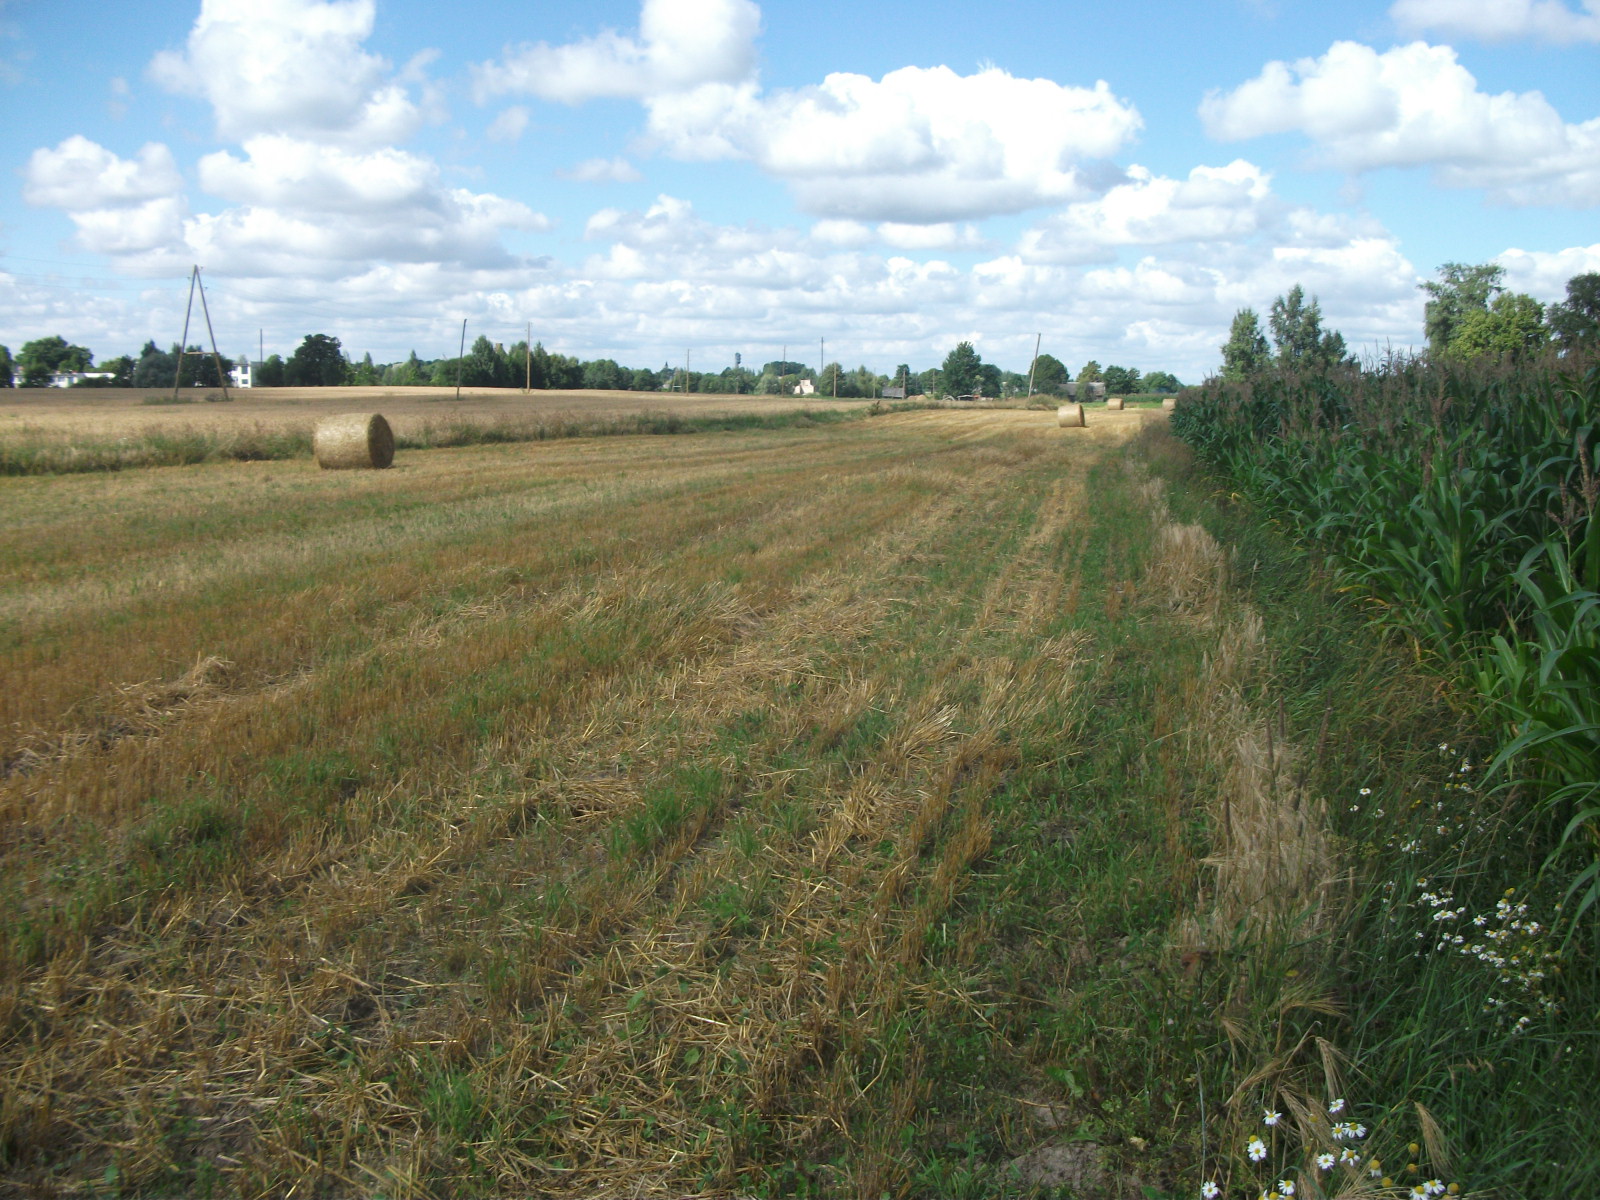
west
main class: Cropland
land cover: Maize
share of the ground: > 75 %
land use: Agriculture (excluding fallow land and kitchen gardens)
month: August
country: LV
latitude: 56.4187
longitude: 26.4715
